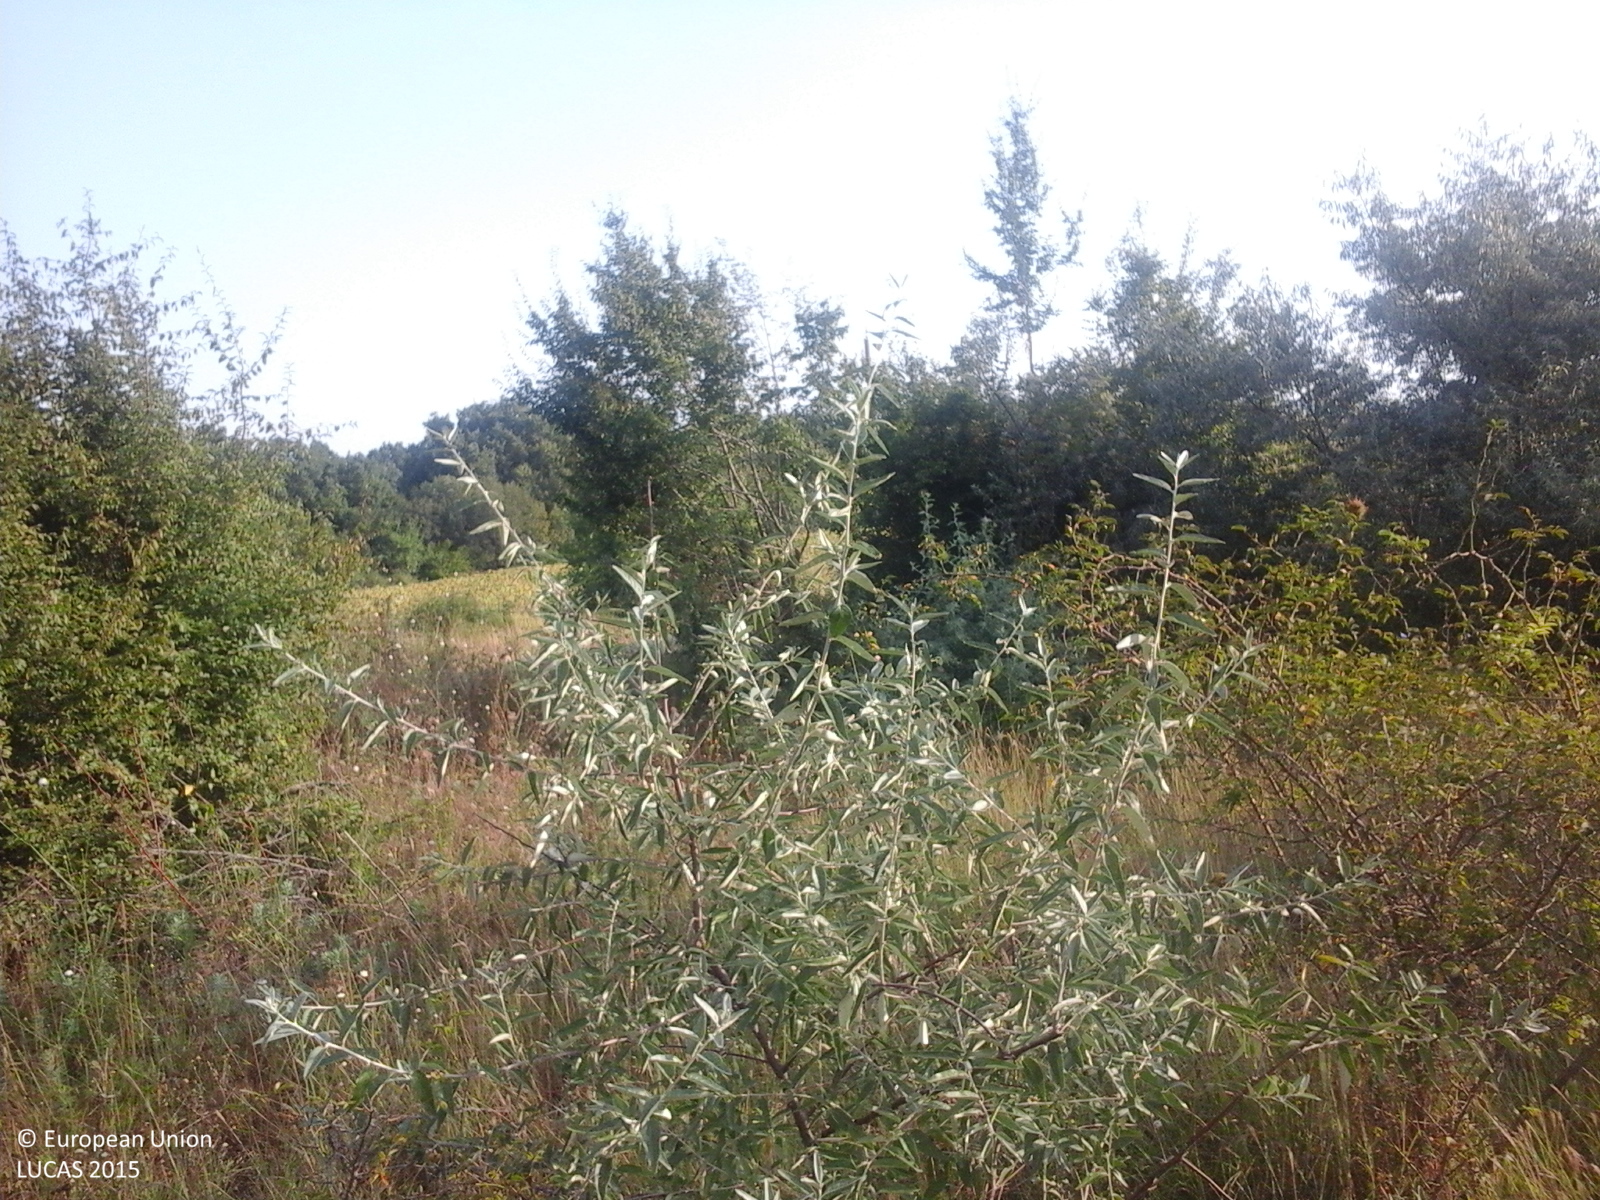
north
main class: Grassland
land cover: Grassland with sparse tree/shrub cover
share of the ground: > 75 %
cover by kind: herbaceous plants 95 %, broadleaved forest trees 5 %
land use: Semi-natural and natural areas not in use
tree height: > 5 m
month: August
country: RO
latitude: 44.0579
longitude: 27.9648
